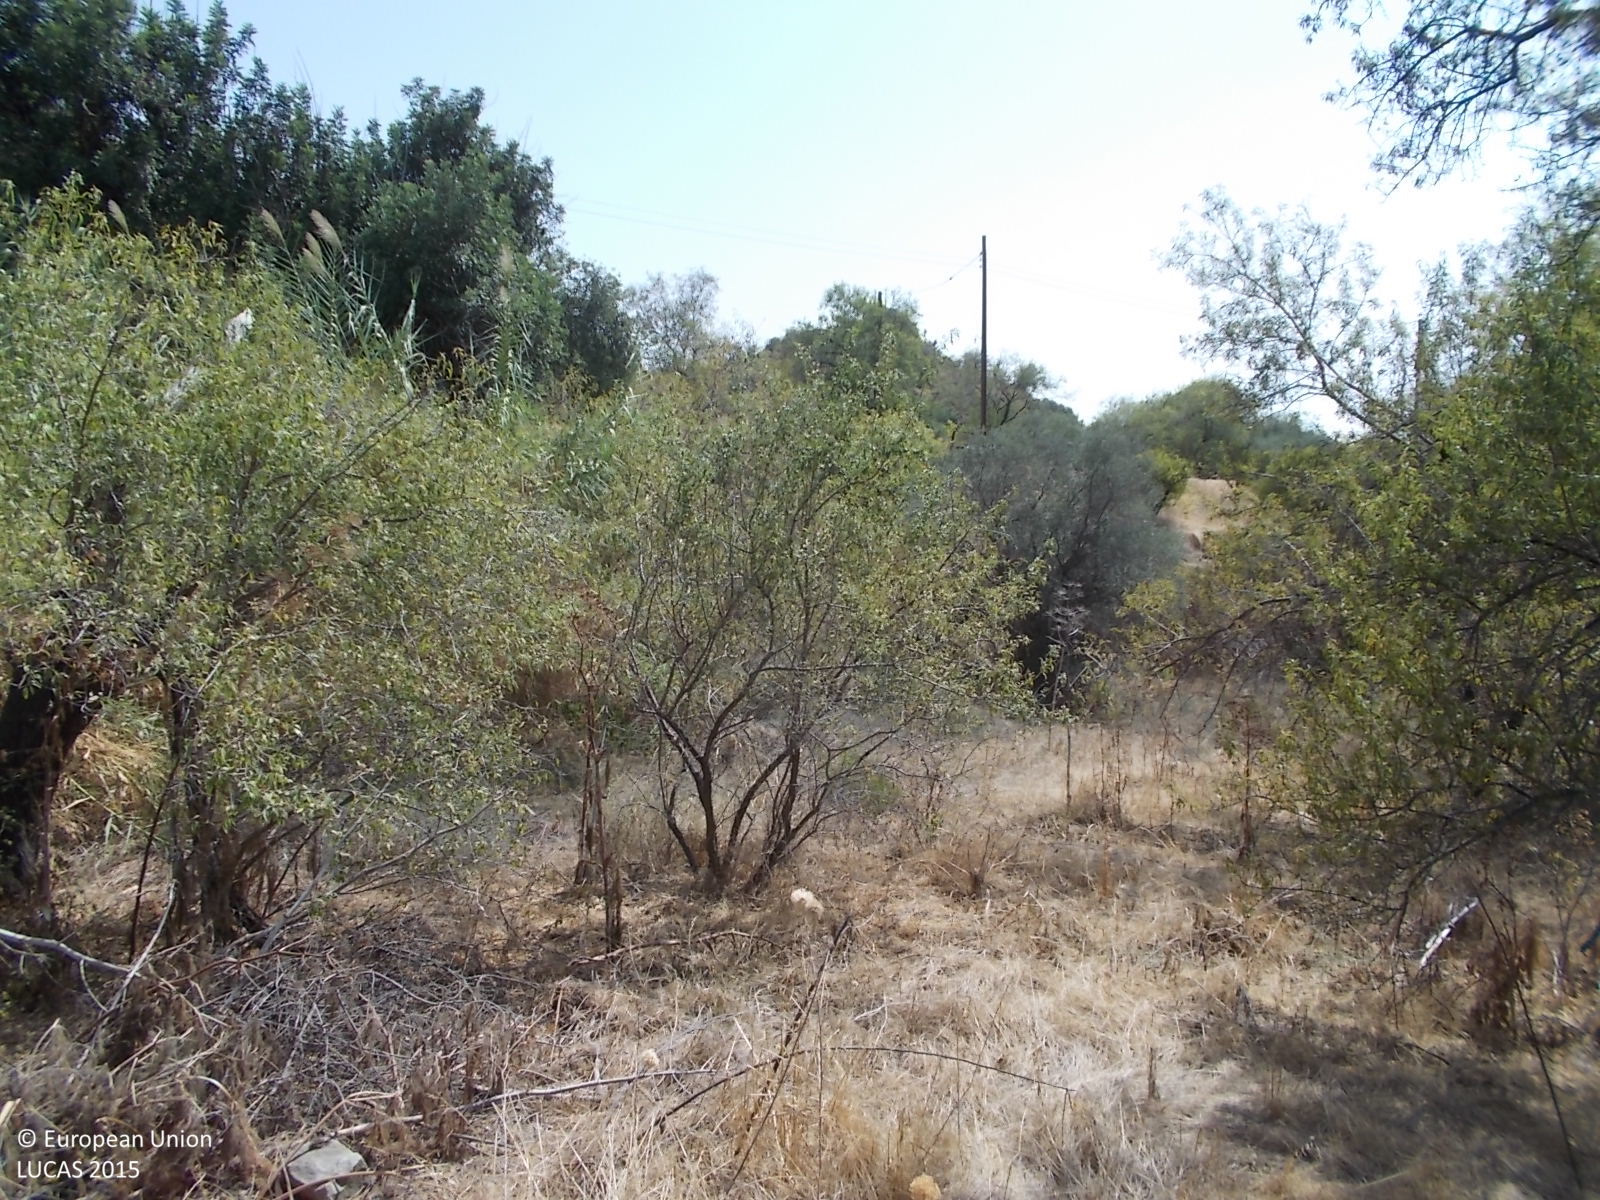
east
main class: Cropland
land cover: Nuts trees
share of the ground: 25 - 50 %
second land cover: Spontaneously vegetated surfaces
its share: > 75 %
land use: Abandoned areas
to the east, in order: Nuts trees; Spontaneously vegetated surfaces; Broadleaved woodland; Abandoned hedges; Paved roads, cycling and walking lanes; Electric lines; Shrubland with sparse tree cover; Fences; Other fruit trees and berries; Fences; Grassland with sparse tree/shrub cover; Artificial constructions in urban areas; Spontaneously vegetated surfaces; Nuts trees; Tracks; Nuts trees; Spontaneously vegetated surfaces; Tracks; Broadleaved woodland; Other fruit trees and berries
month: April
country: CY
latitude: 34.8659
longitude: 33.1583
